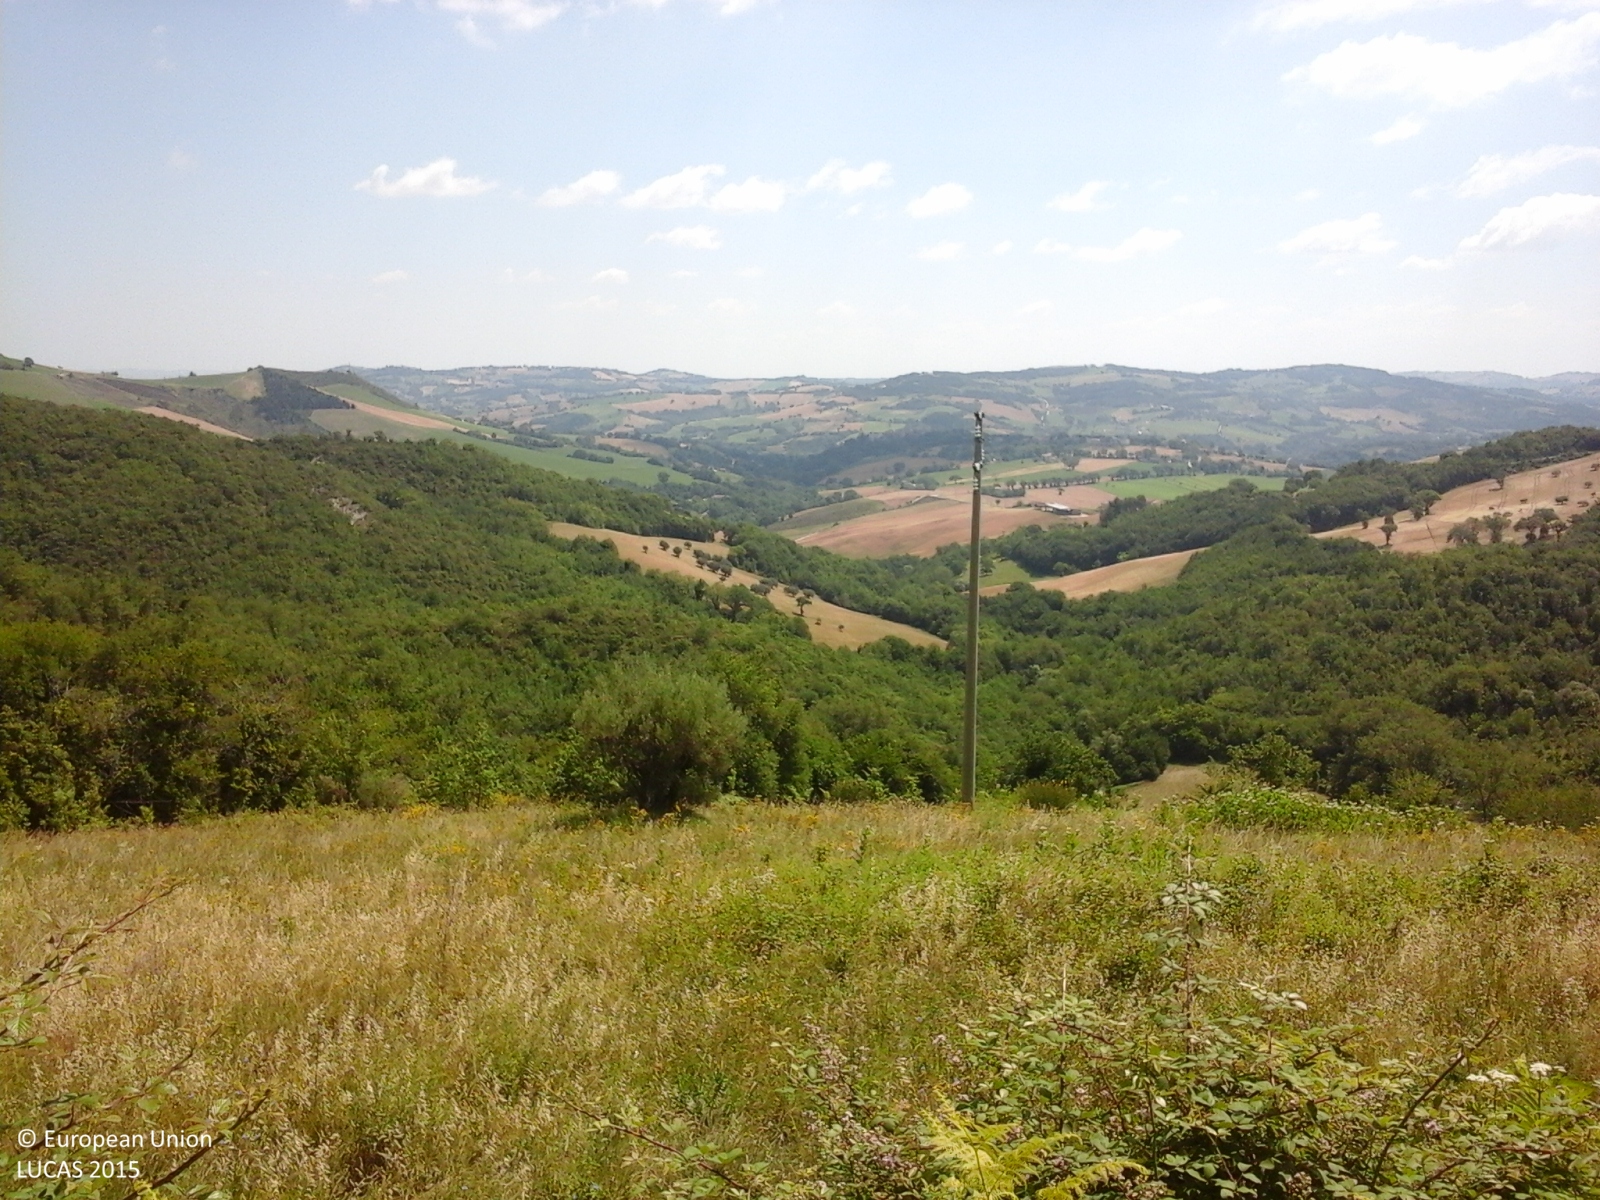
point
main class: Woodland
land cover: Broadleaved woodland
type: thermophilous deciduous forest
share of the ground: > 75 %
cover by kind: broadleaved forest trees 90 %, shrubs 5 %, herbaceous plants 5 %
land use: Forestry
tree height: > 5 m
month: June
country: IT
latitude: 43.1636
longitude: 13.2015
